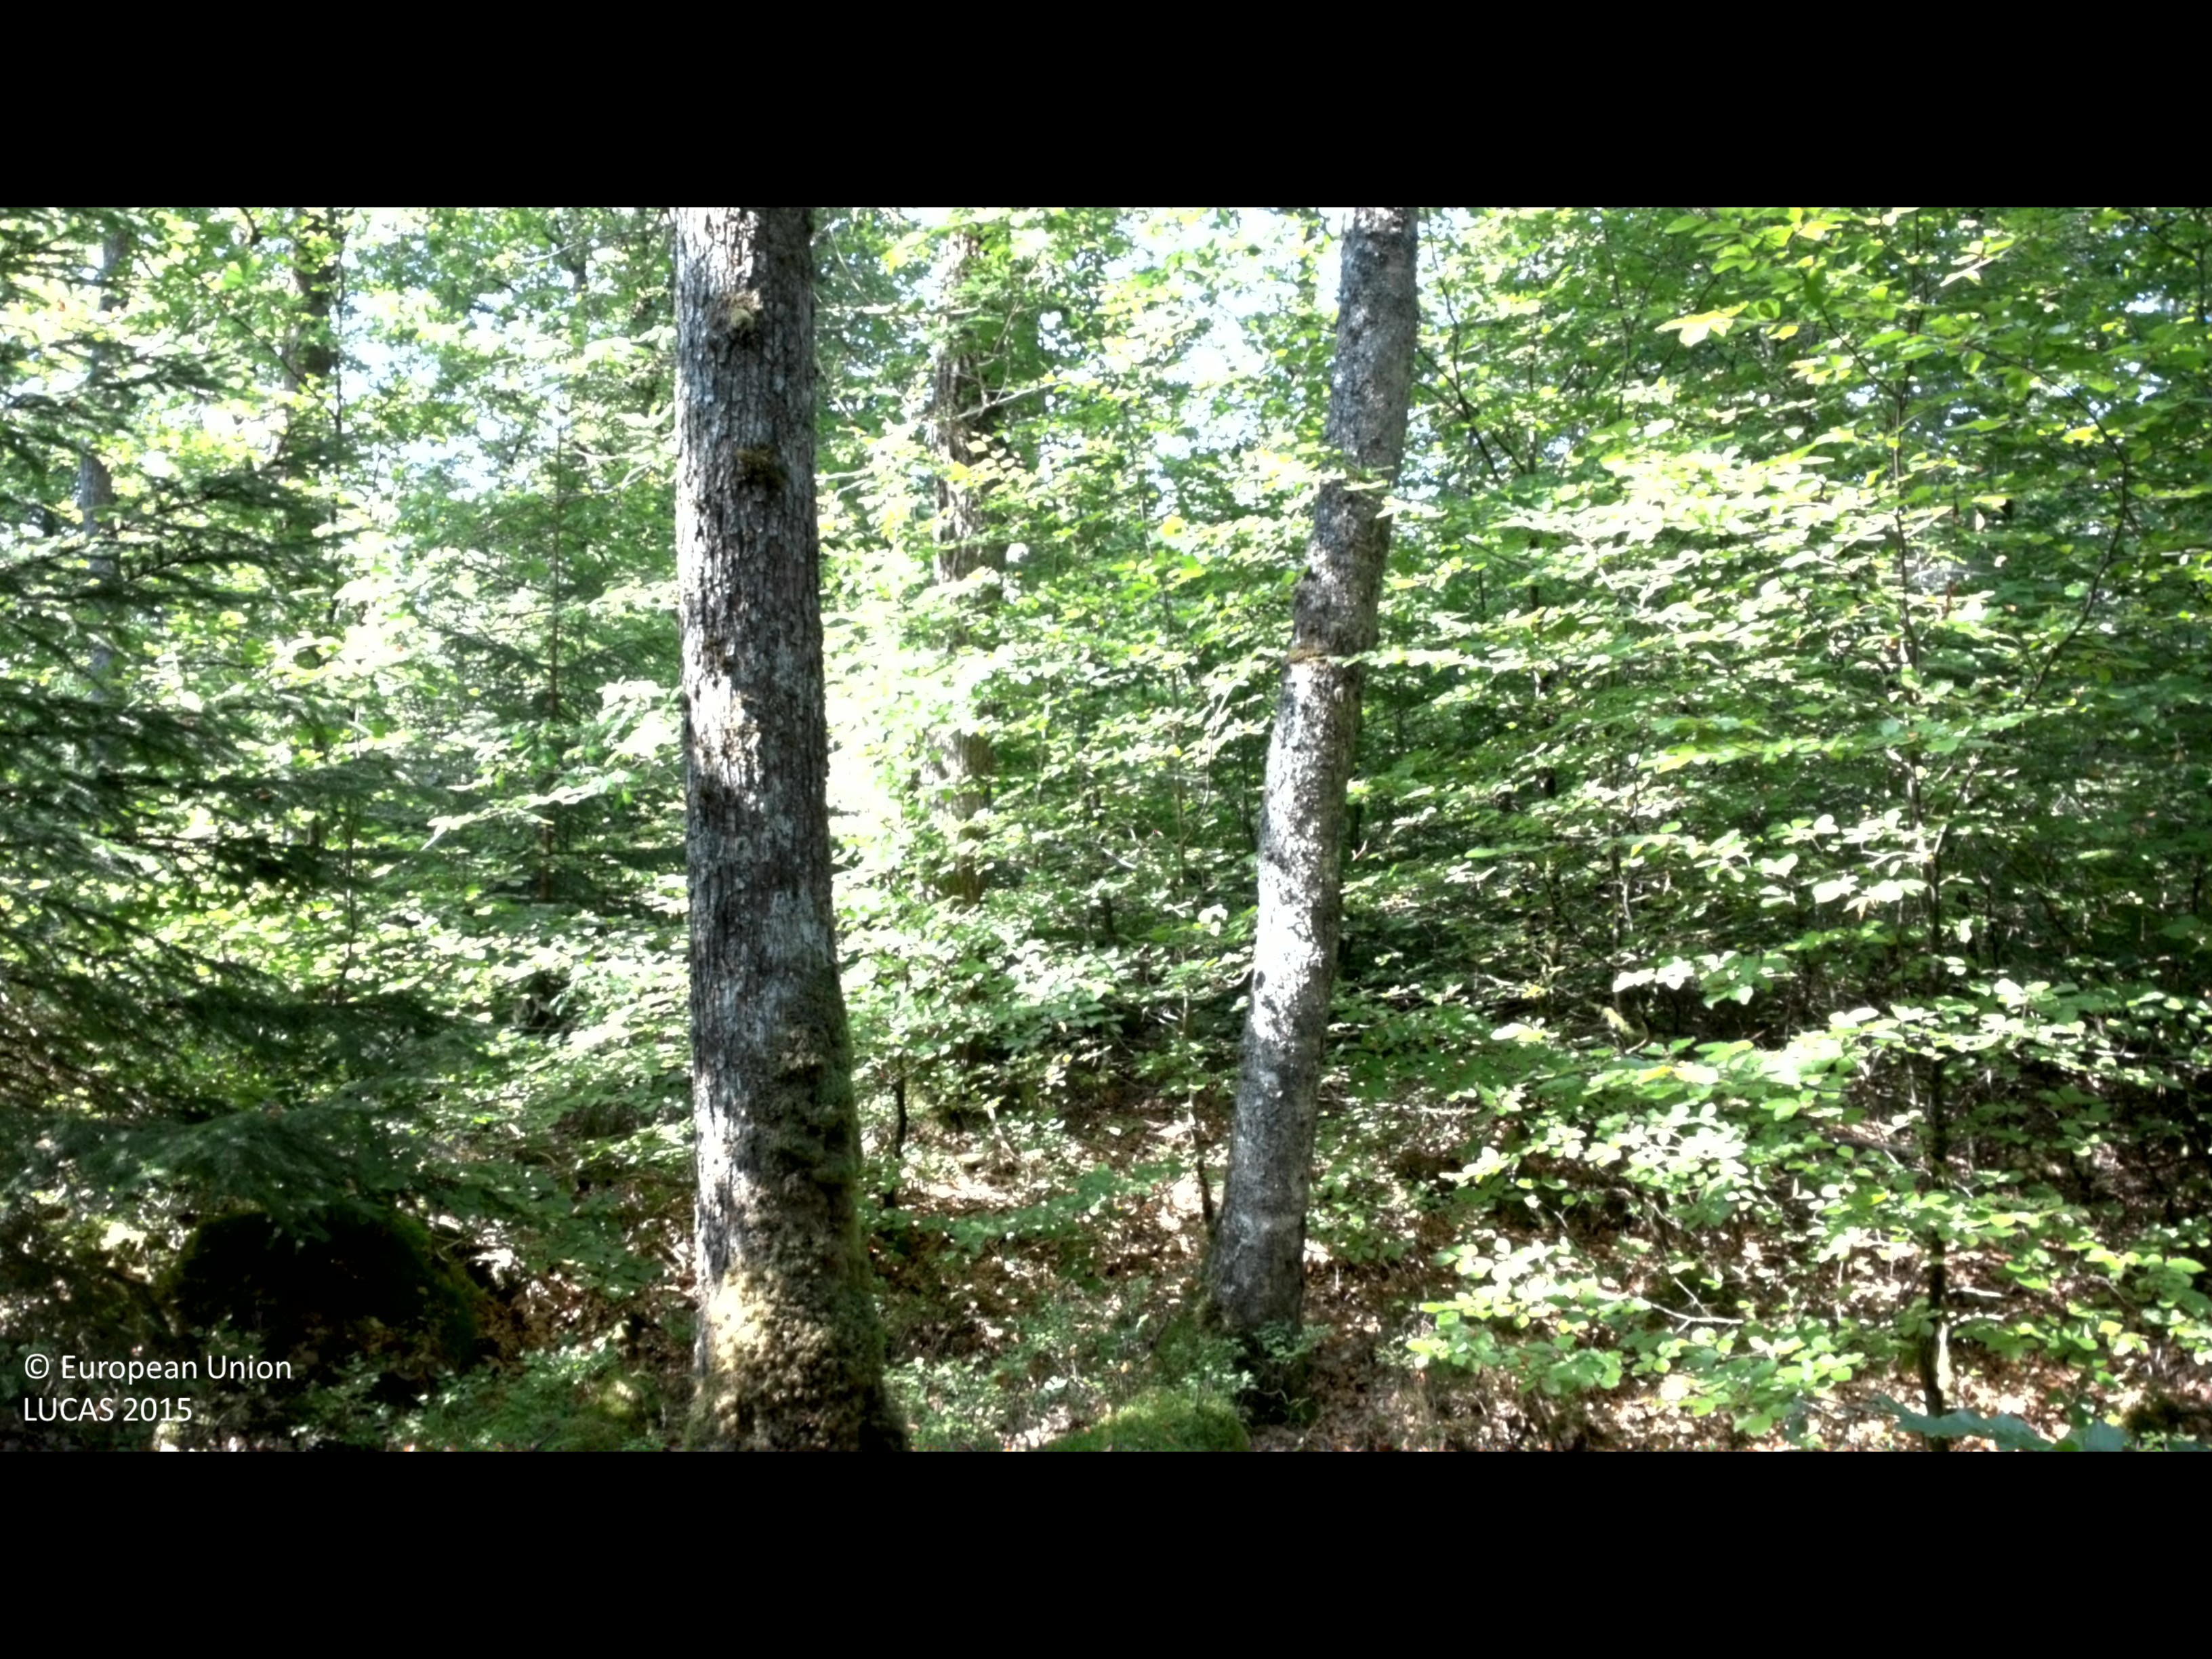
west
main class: Woodland
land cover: Broadleaved woodland
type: hemiboreal forest and nemoral coniferous forest and mixed broadleaved-coniferous forest
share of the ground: > 75 %
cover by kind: broadleaved forest trees 85 %, shrubs 10 %, coniferous forest trees 5 %
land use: Forestry
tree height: > 5 m
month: August
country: SE
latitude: 56.8849
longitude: 13.2297
